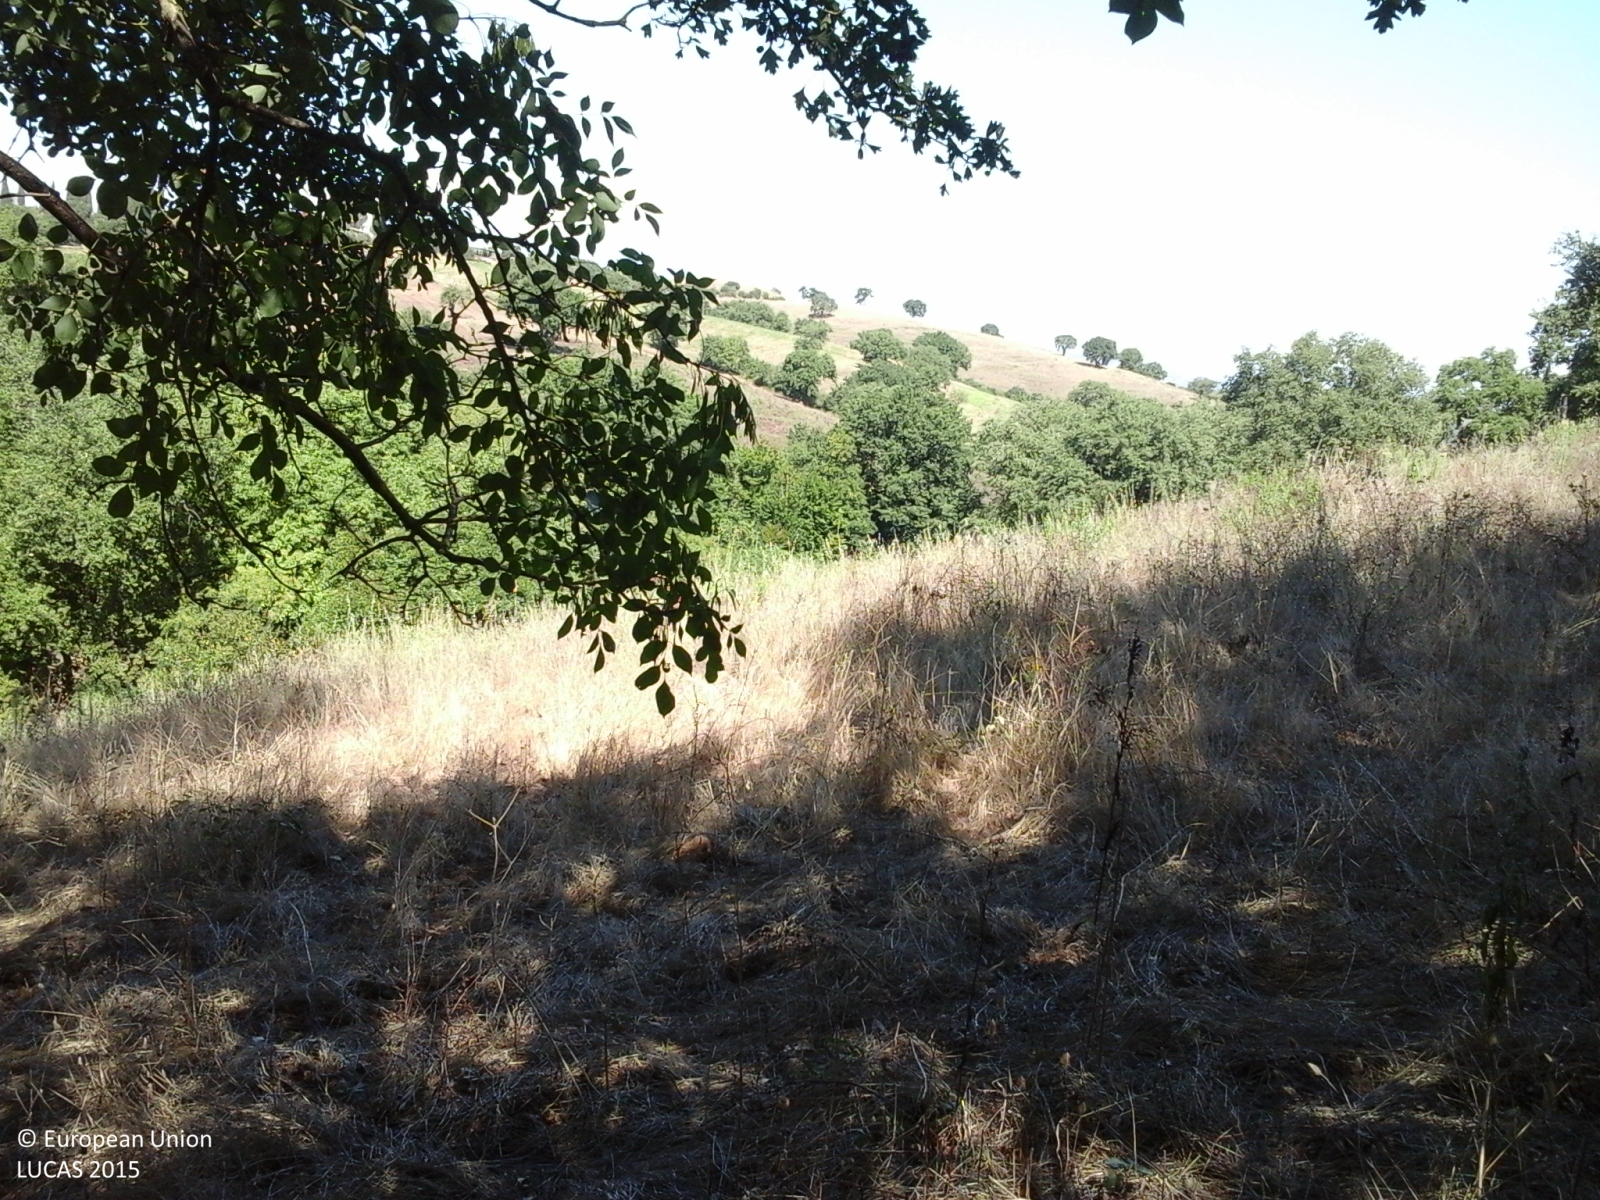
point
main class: Grassland
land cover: Grassland with sparse tree/shrub cover
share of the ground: > 75 %
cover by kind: herbaceous plants 95 %, broadleaved forest trees 5 %
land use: Agriculture (excluding fallow land and kitchen gardens)
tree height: > 5 m
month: September
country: IT
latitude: 42.7369
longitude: 11.2296
